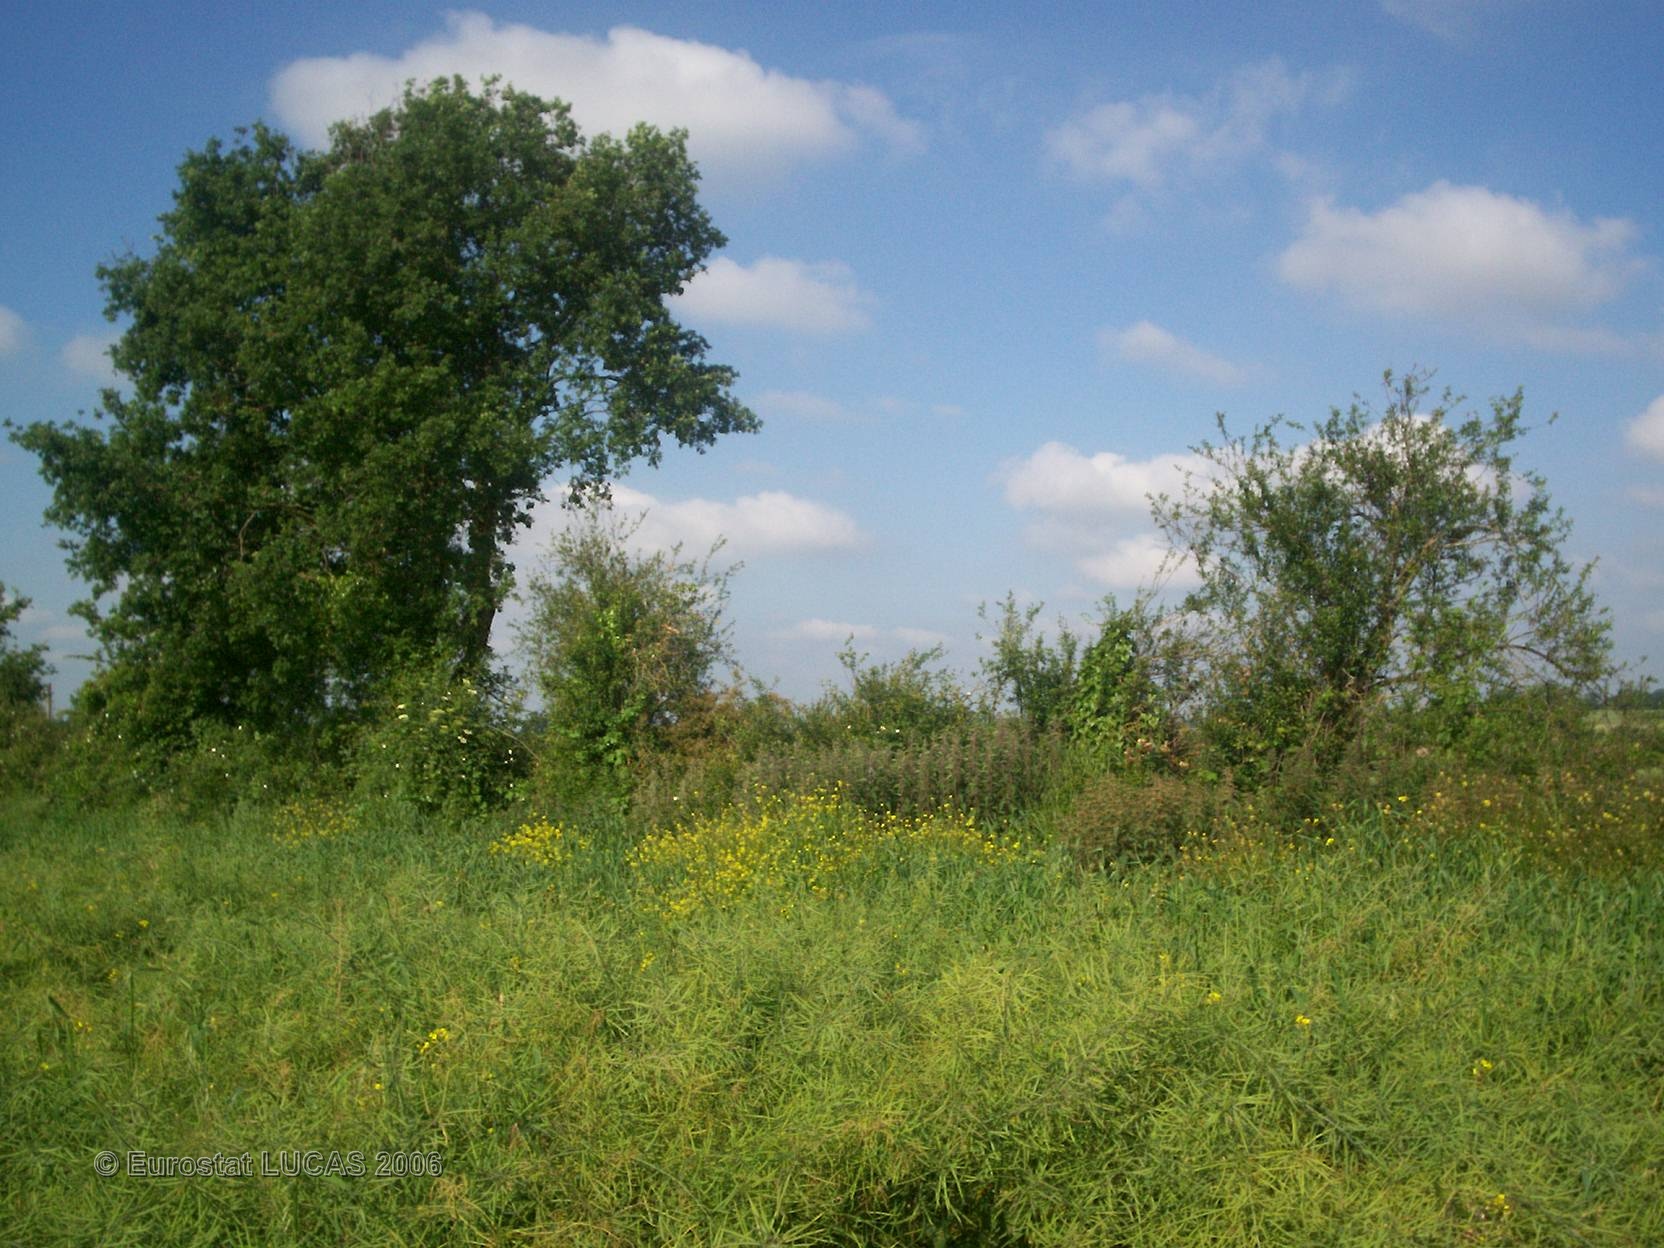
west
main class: Cropland
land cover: Rape and turnip rape
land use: Agriculture (excluding fallow land and kitchen gardens)
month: June
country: FR
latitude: 48.0361
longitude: -0.6165
